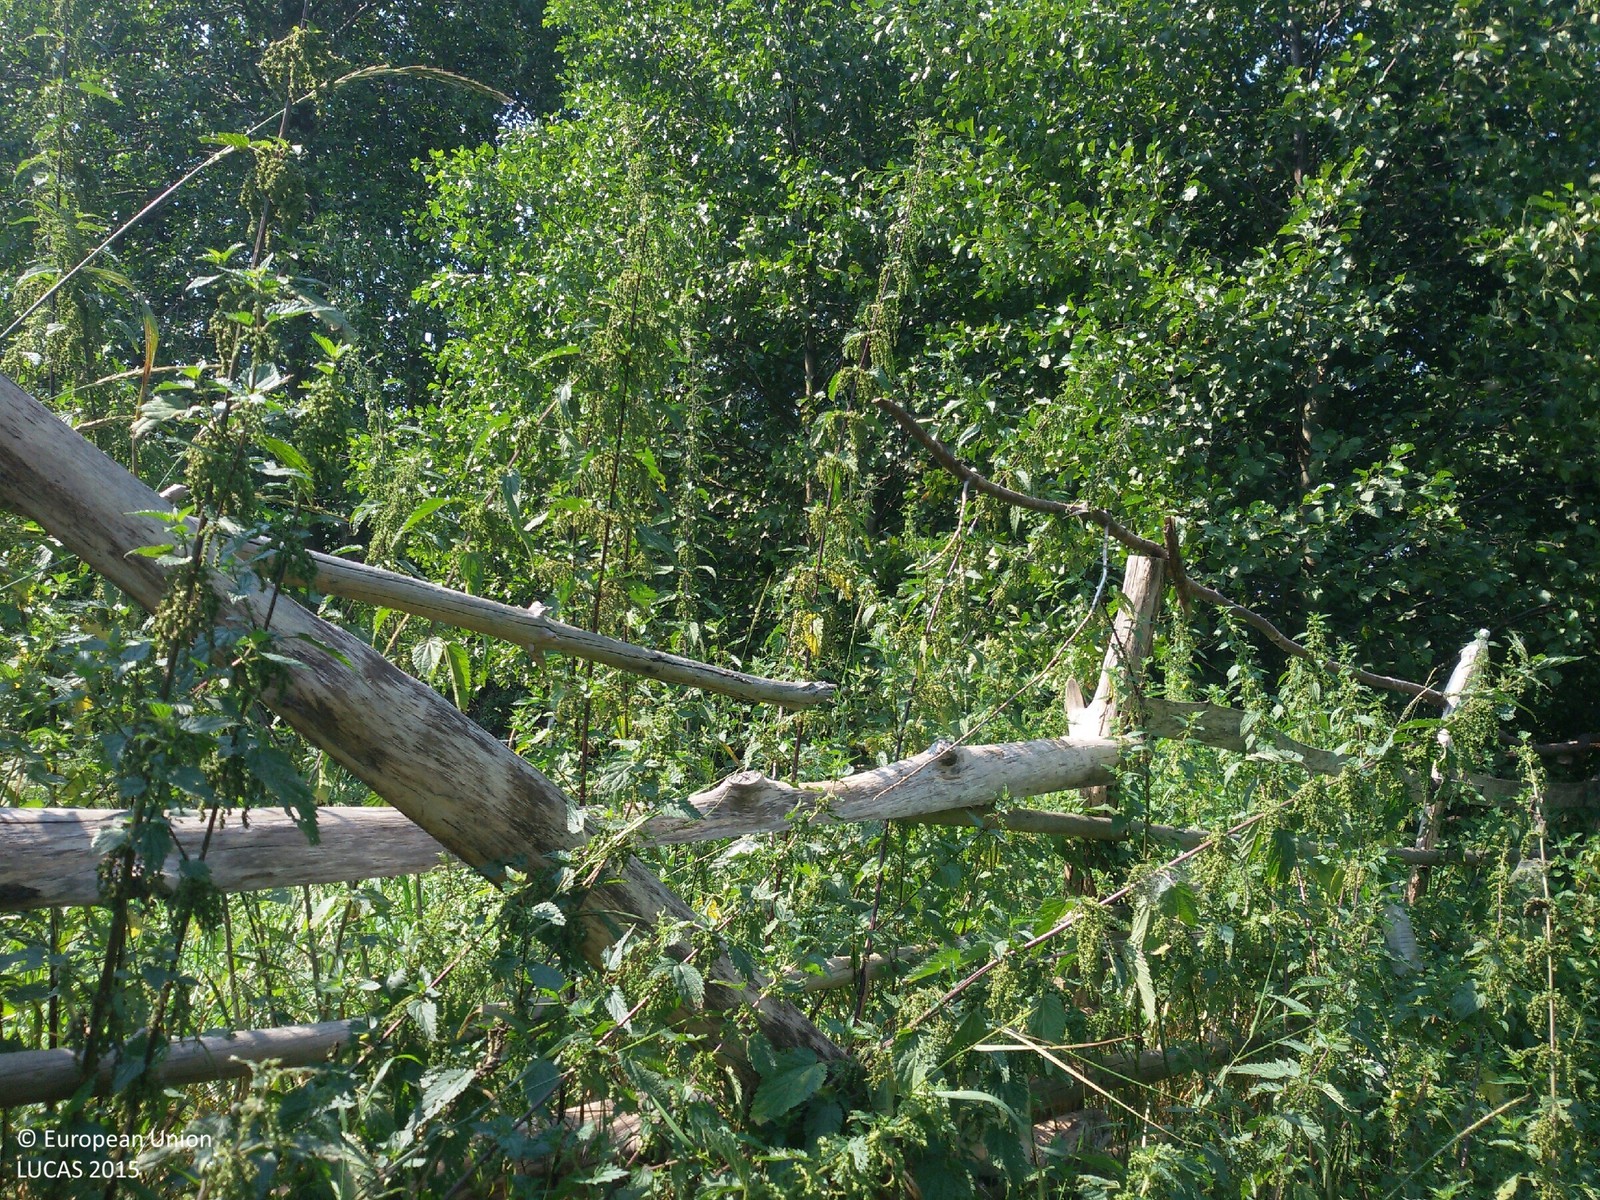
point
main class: Woodland
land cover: Broadleaved woodland
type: mesophytic deciduous forest
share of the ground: > 75 %
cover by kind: broadleaved forest trees 100 %
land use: Semi-natural and natural areas not in use
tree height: > 5 m
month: August
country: PL
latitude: 51.0697
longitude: 20.9613
